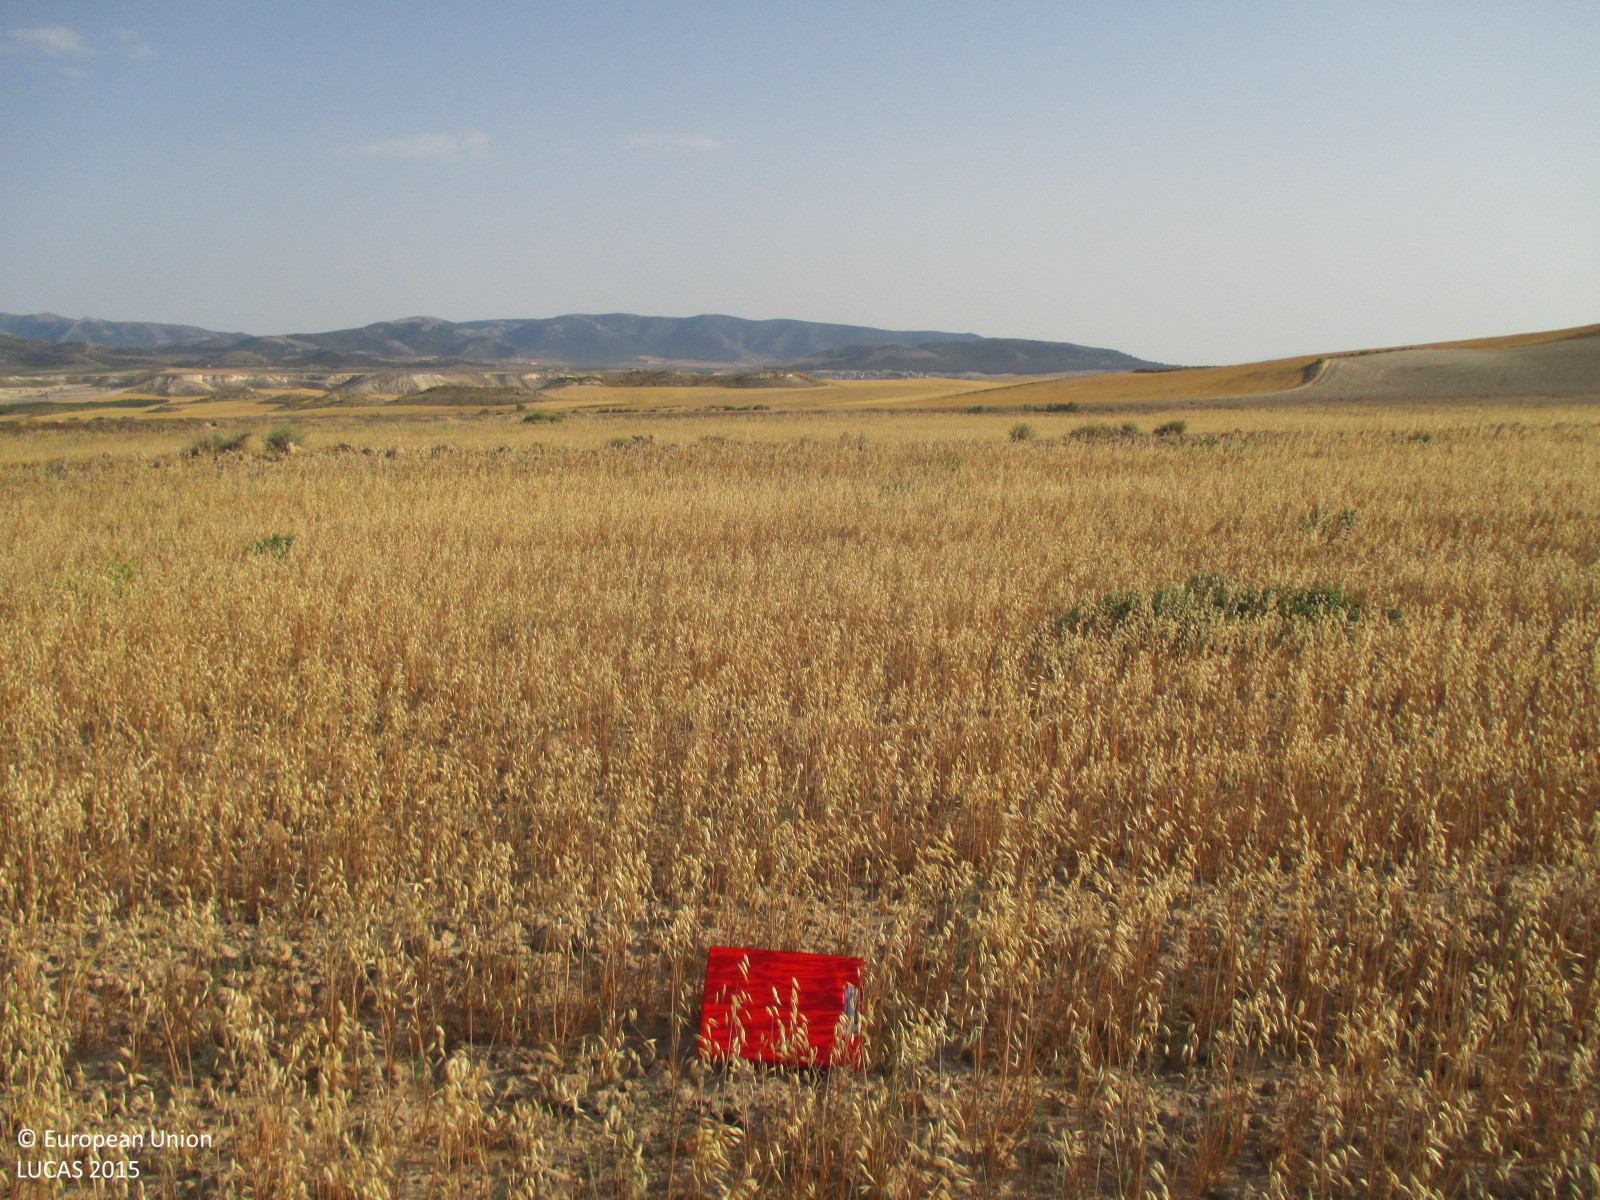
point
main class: Cropland
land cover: Oats
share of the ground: 25 - 50 %
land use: Agriculture (excluding fallow land and kitchen gardens)
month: June
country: ES
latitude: 37.7669
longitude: -2.4647
